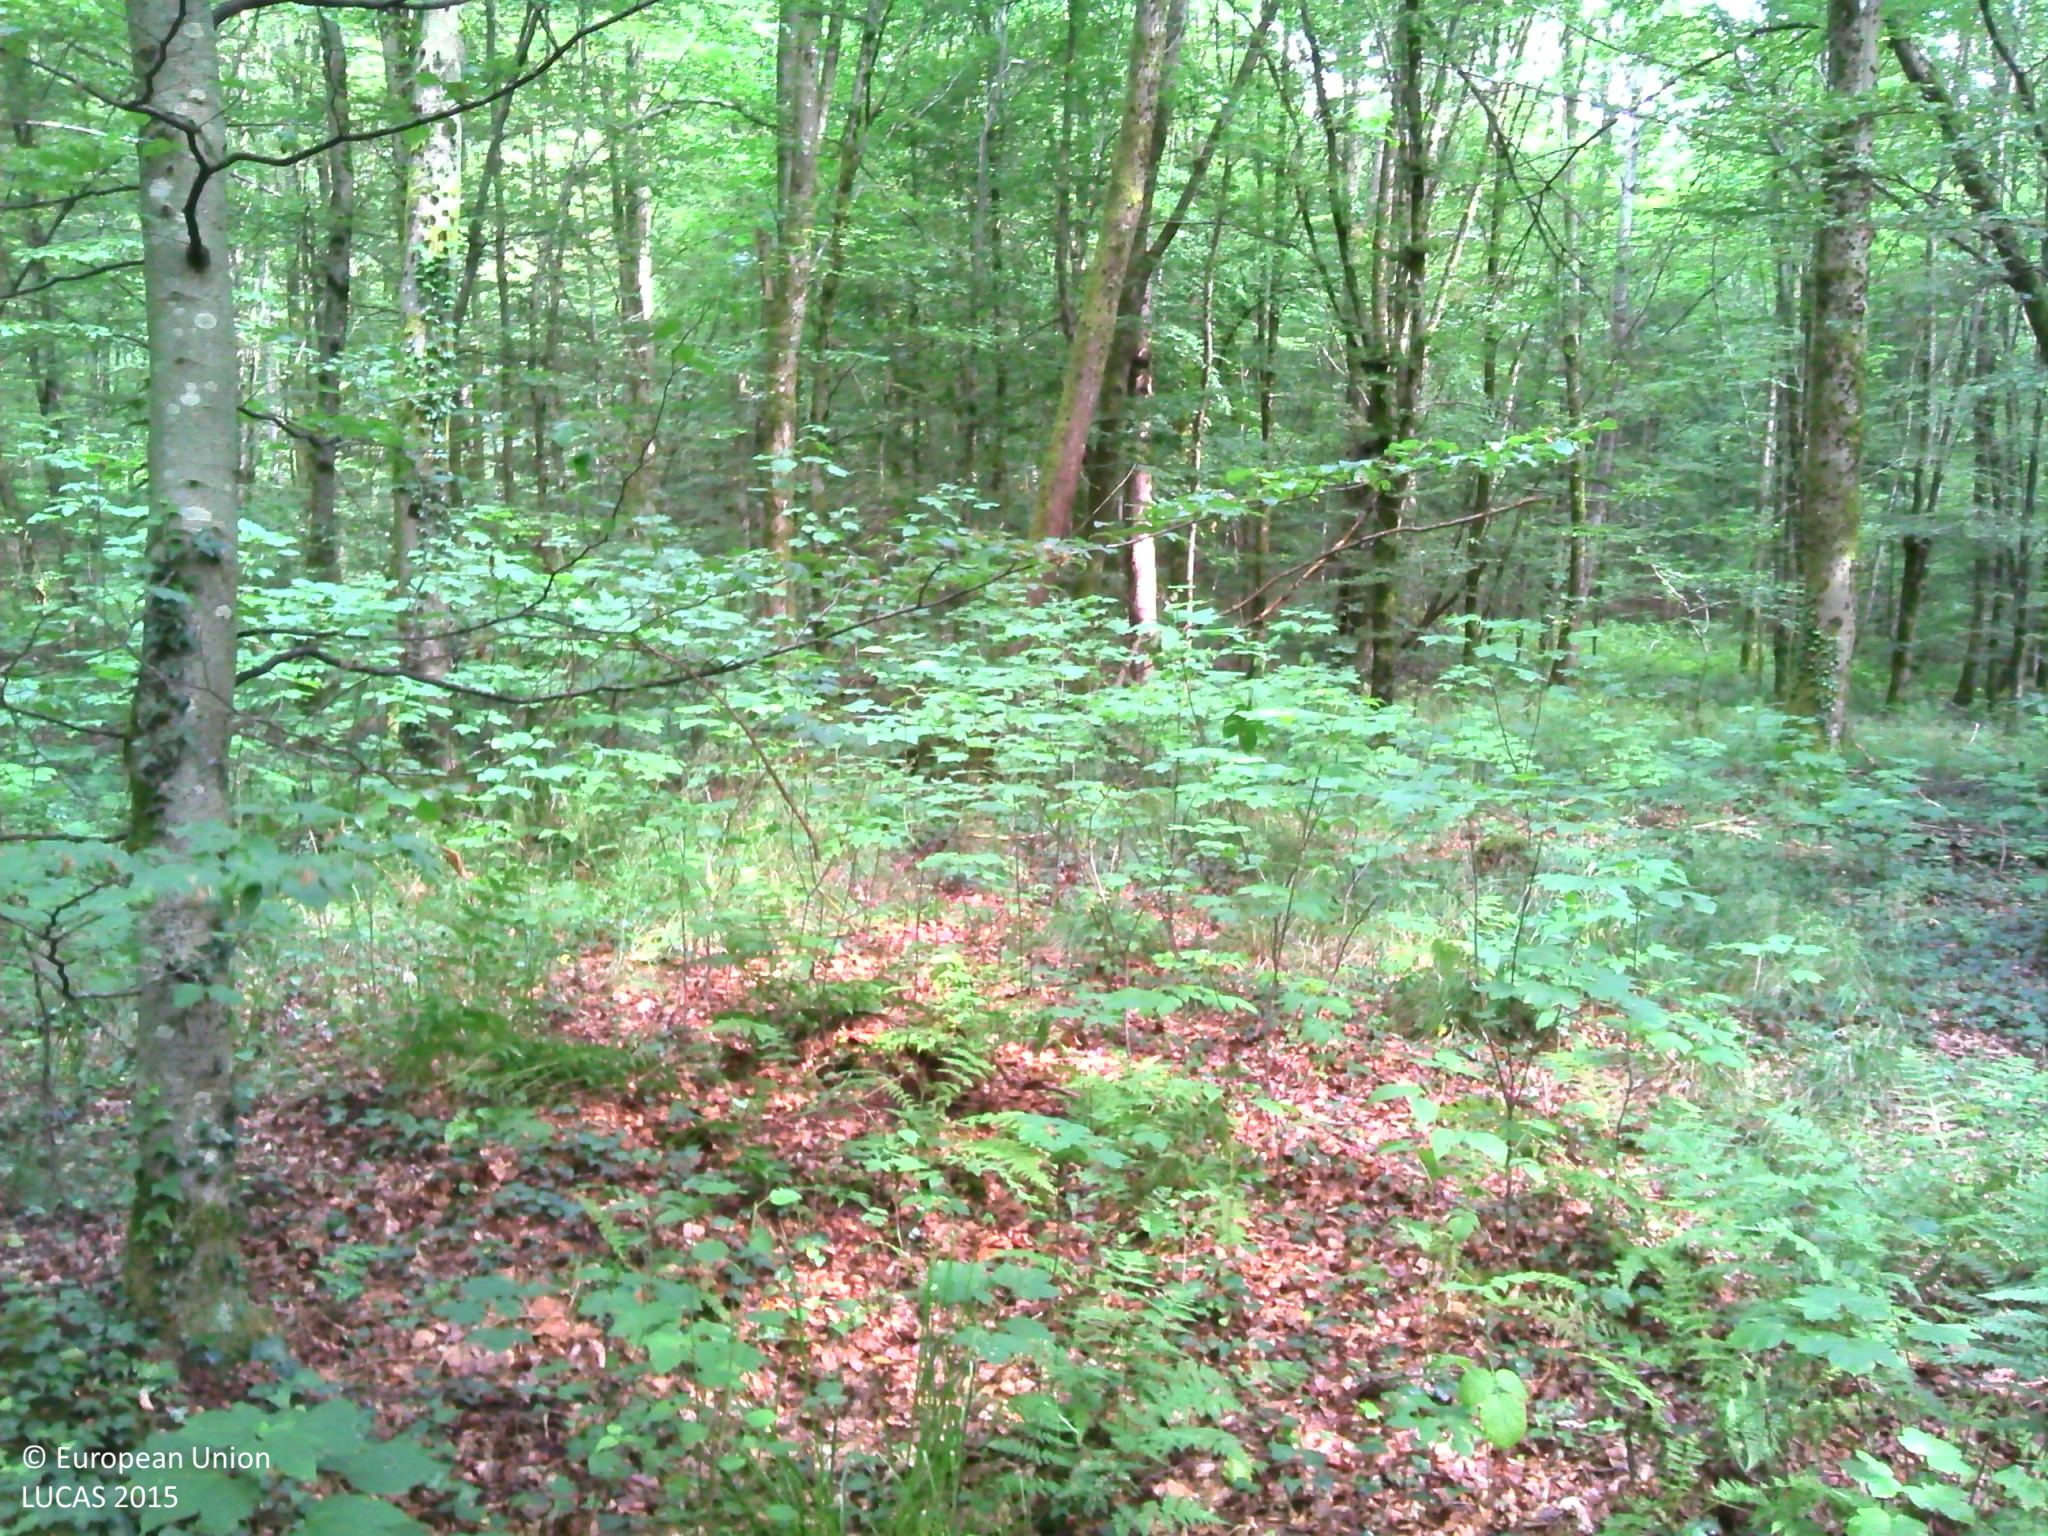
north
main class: Woodland
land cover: Broadleaved woodland
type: beech forest
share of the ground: > 75 %
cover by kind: broadleaved forest trees 95 %, herbaceous plants 5 %
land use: Forestry
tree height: > 5 m
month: July
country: BE
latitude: 49.6125
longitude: 5.5837
